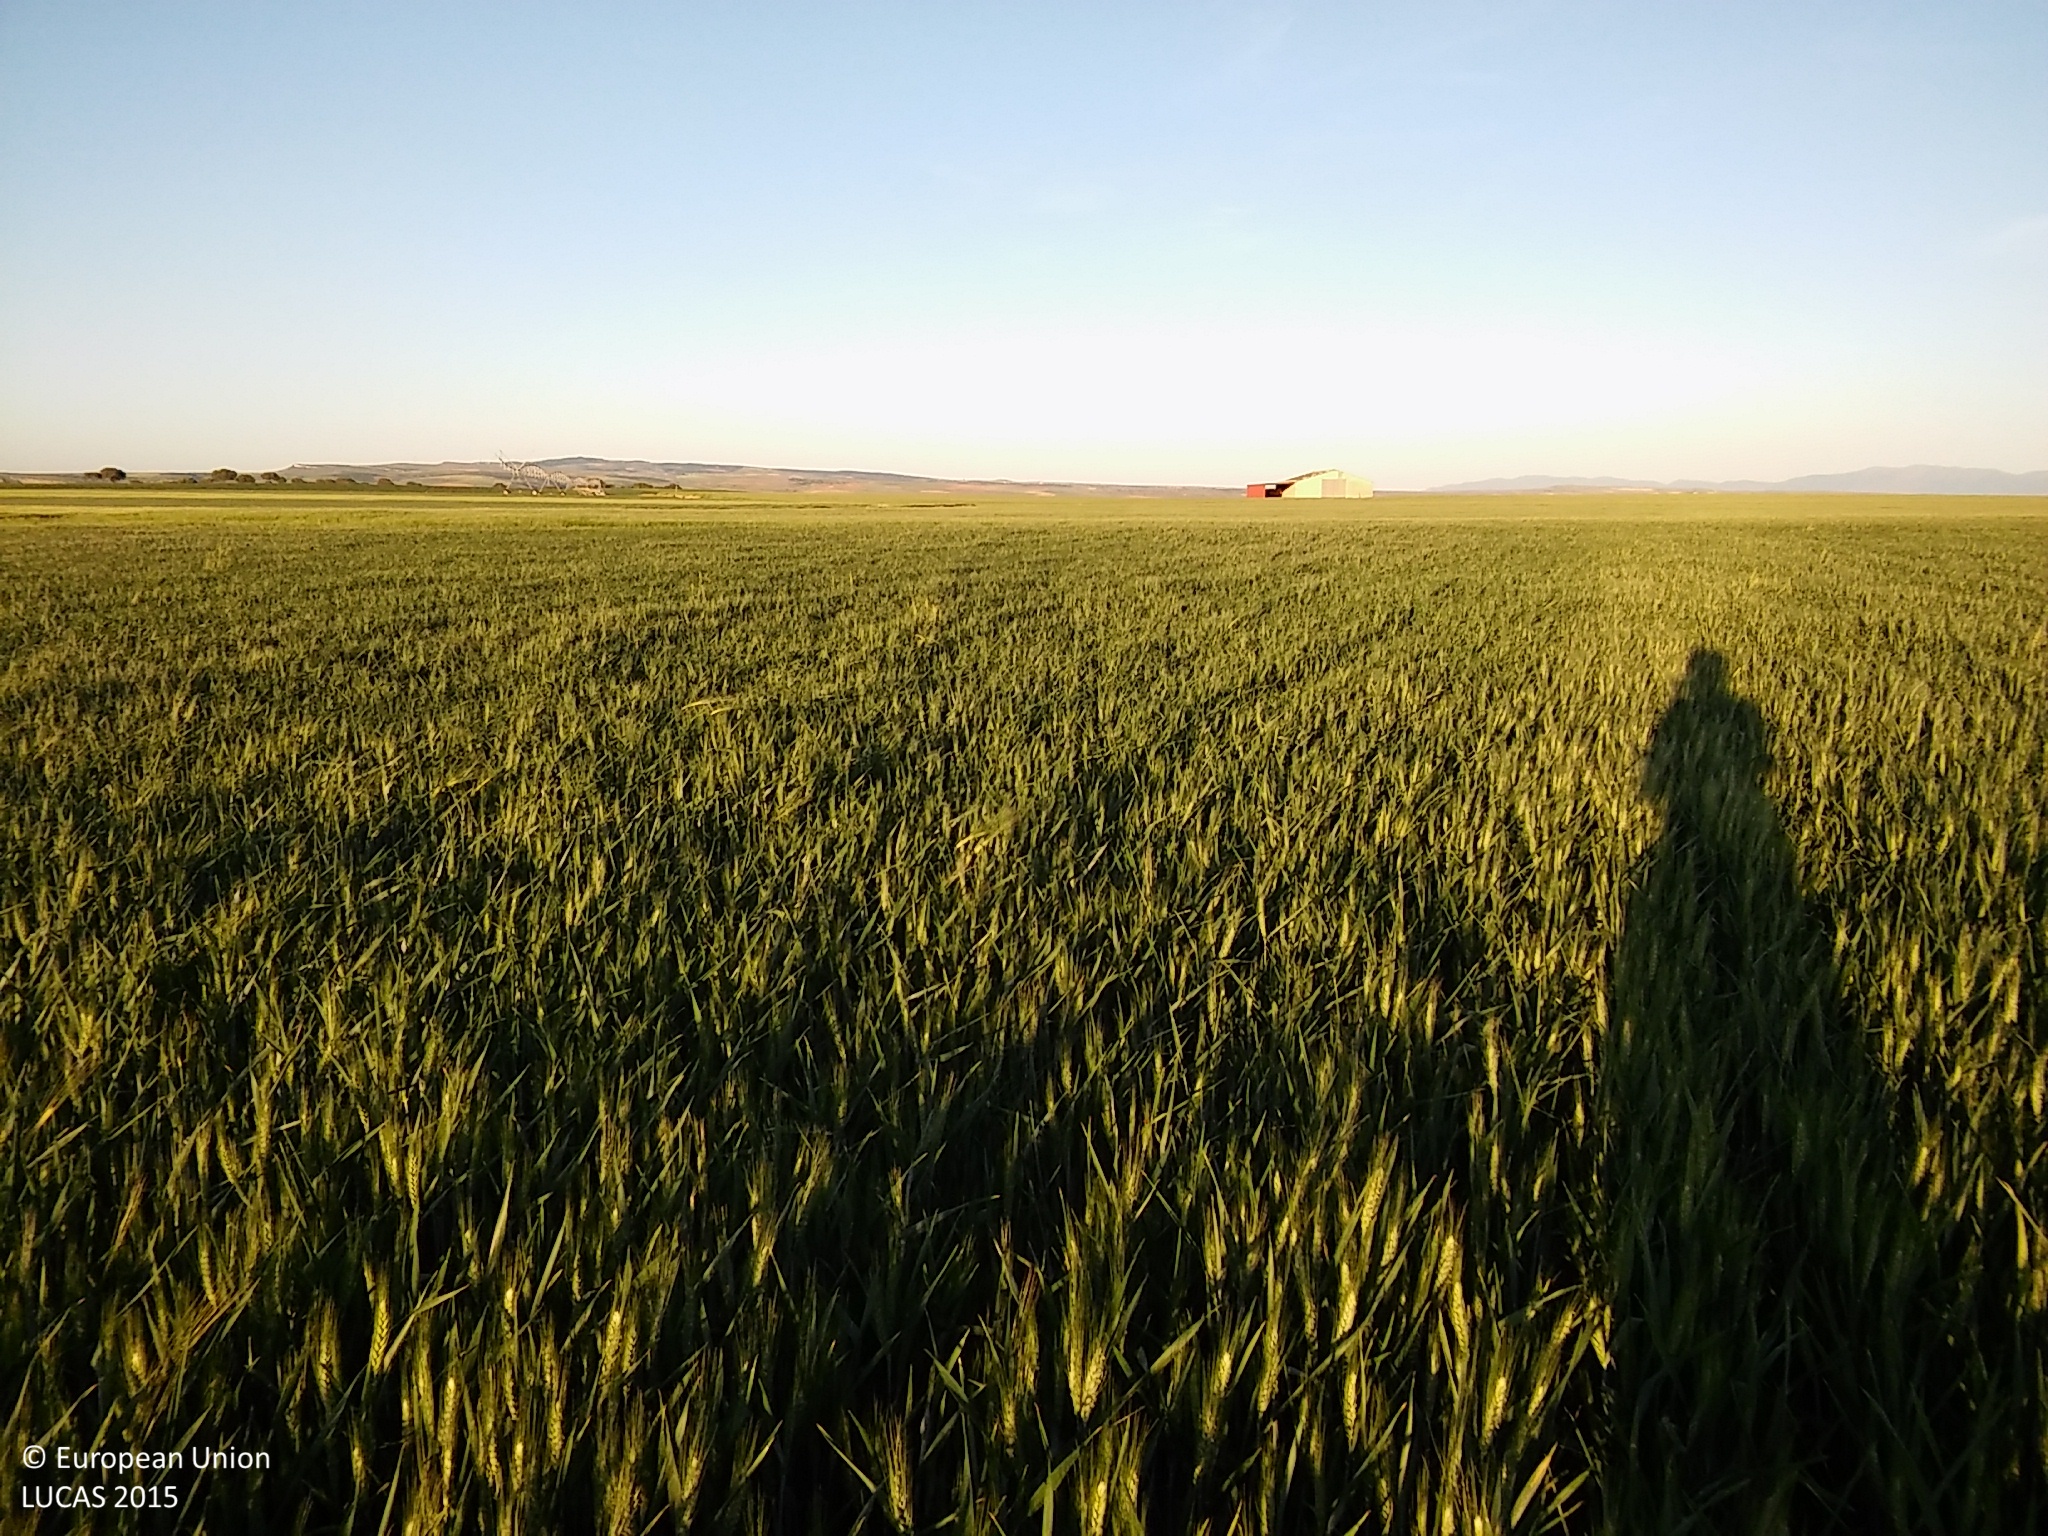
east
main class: Cropland
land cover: Common wheat
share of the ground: > 75 %
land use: Agriculture (excluding fallow land and kitchen gardens)
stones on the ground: 25 - 50 %
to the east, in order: Common wheat; Barley; Grass margins; Tracks; Grass margins; Barley; Common wheat; Barley
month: May
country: ES
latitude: 41.3998
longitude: -4.0129
